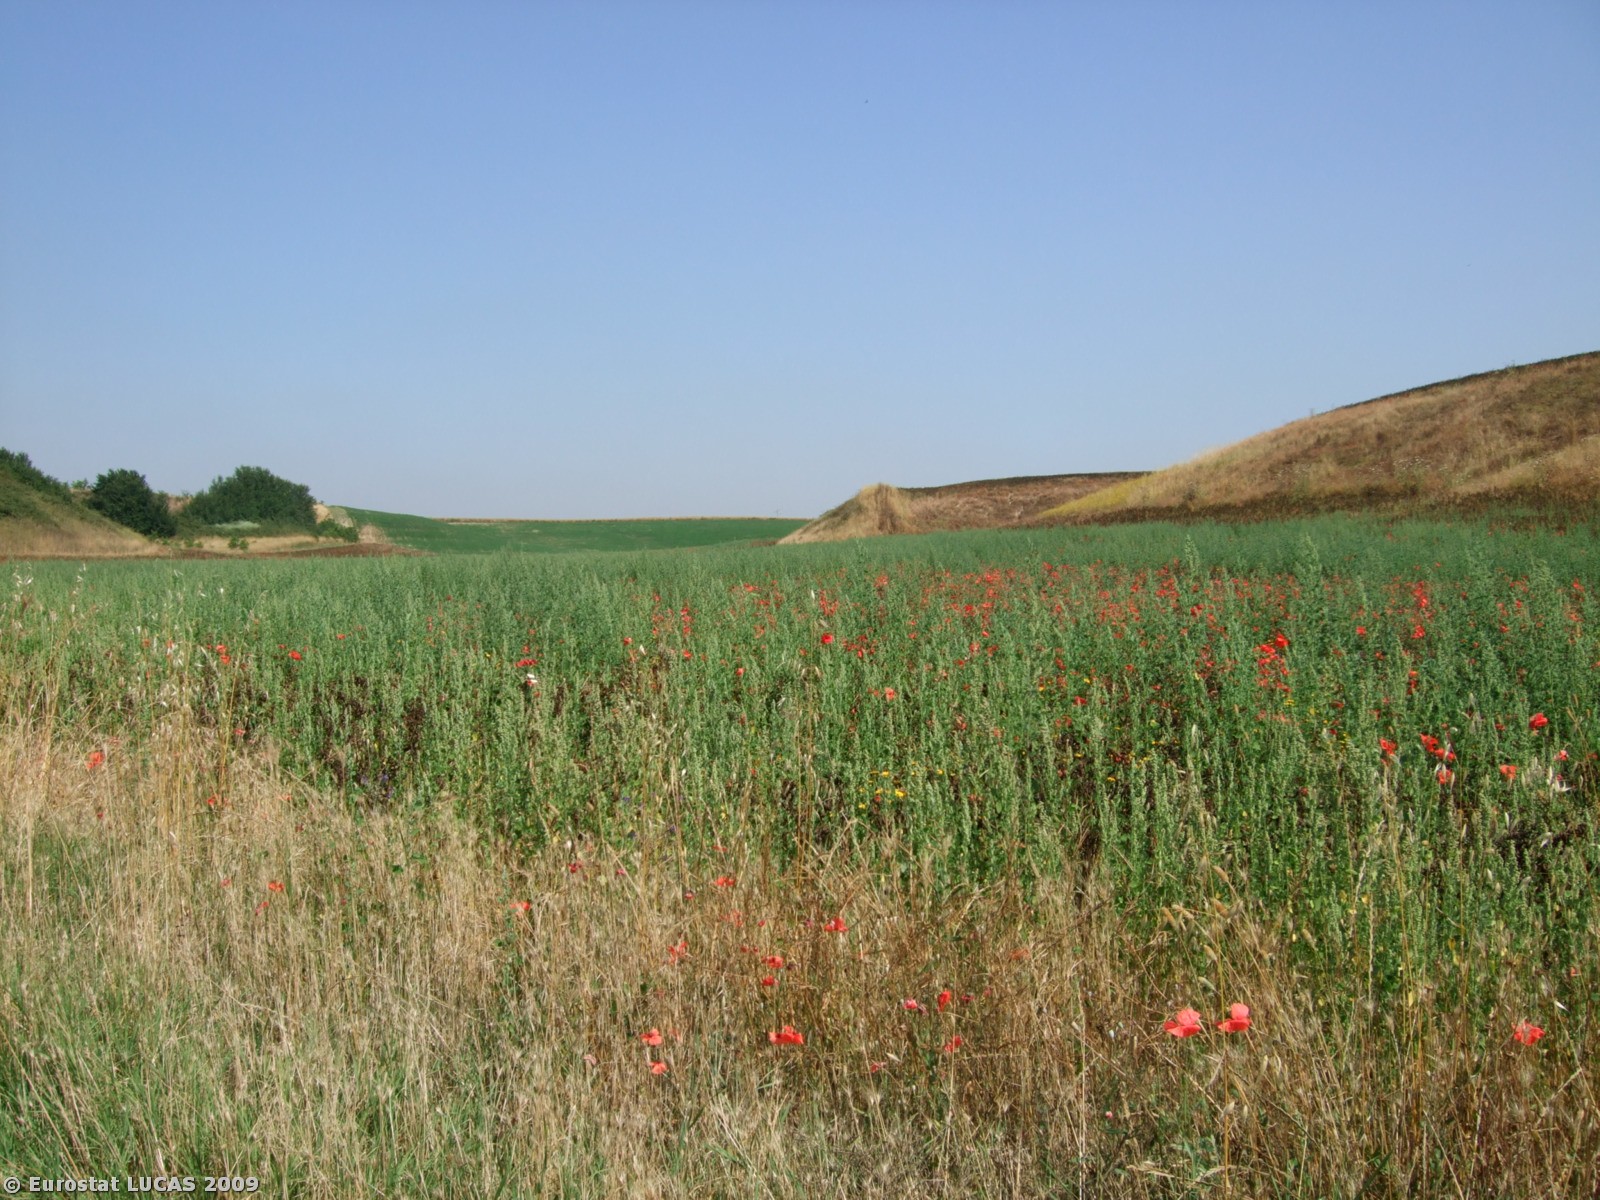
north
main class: Cropland
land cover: Dry pulses
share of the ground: > 75 %
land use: Agriculture (excluding fallow land and kitchen gardens)
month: June
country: IT
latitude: 41.8865
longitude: 12.3172
